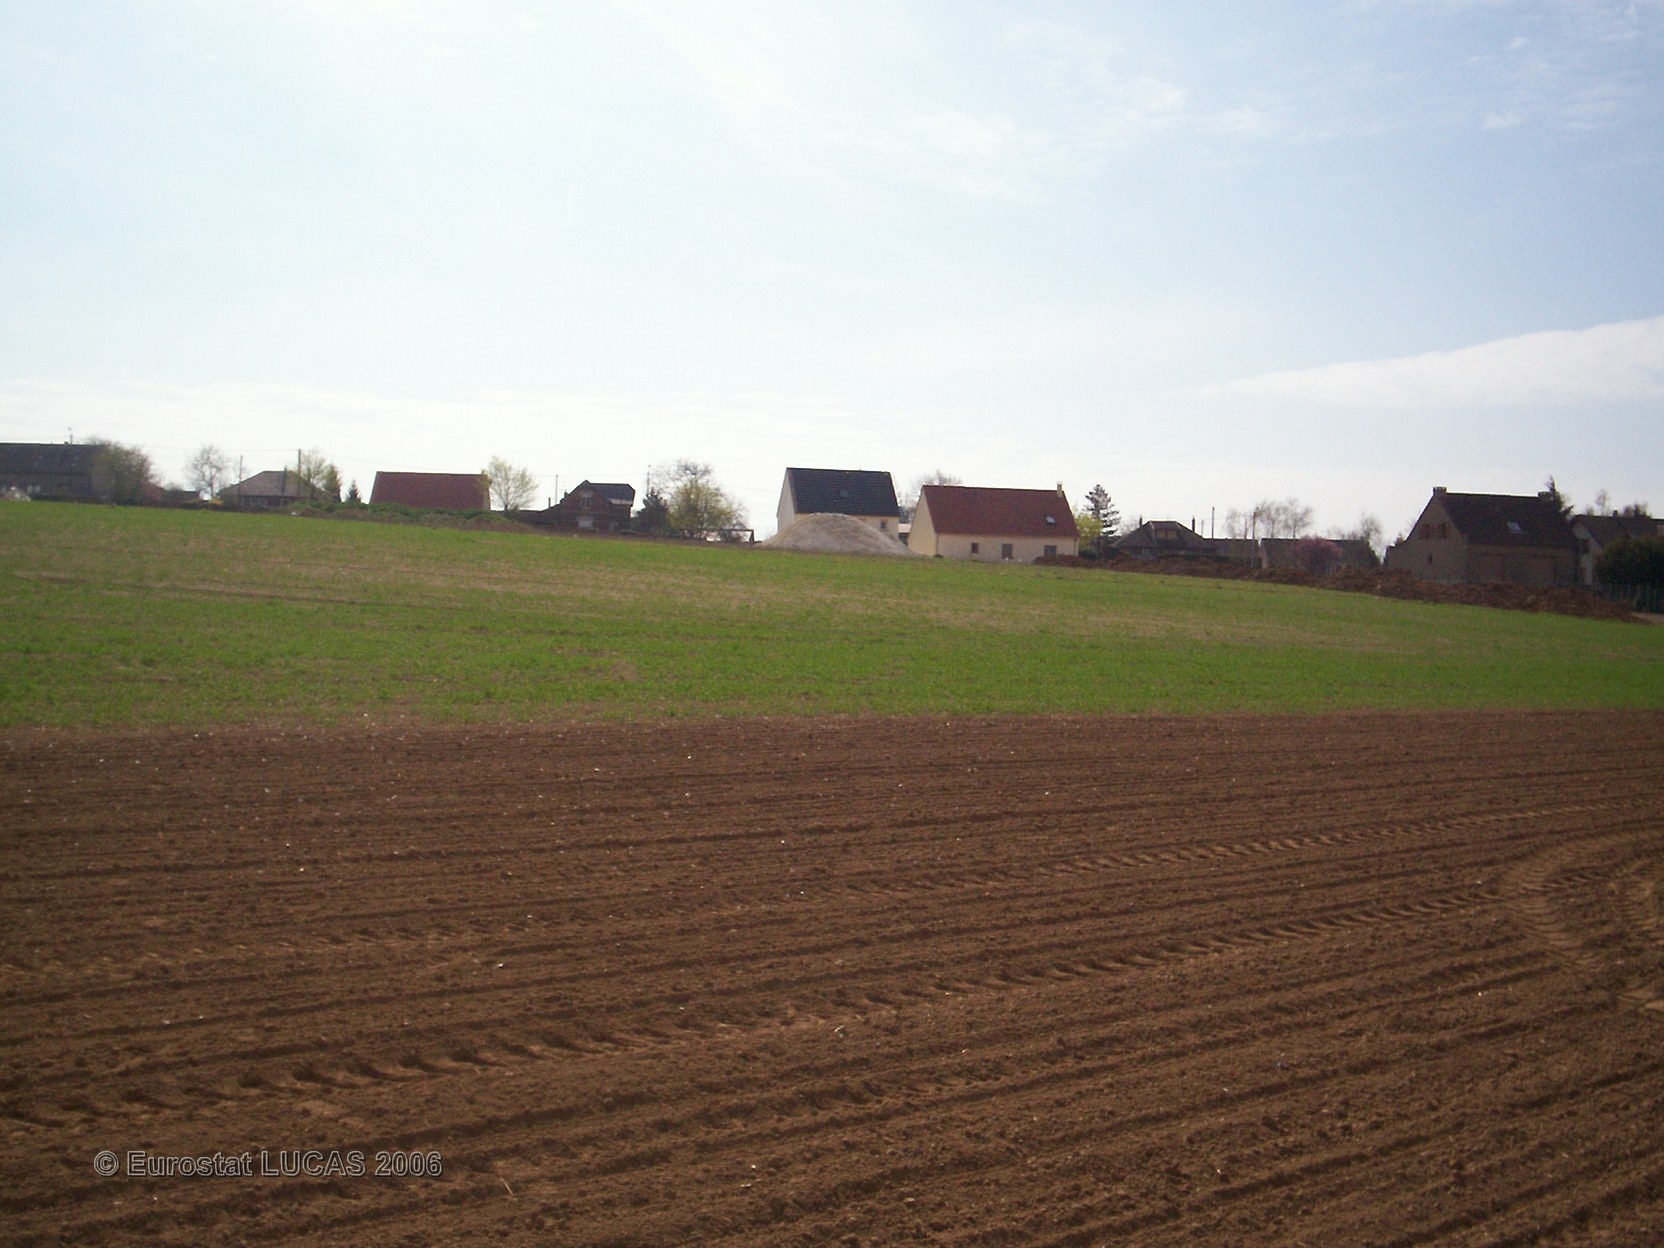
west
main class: Cropland
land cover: Sugar beet
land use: Agriculture (excluding fallow land and kitchen gardens)
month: April
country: FR
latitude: 50.0216
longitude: 2.6889
